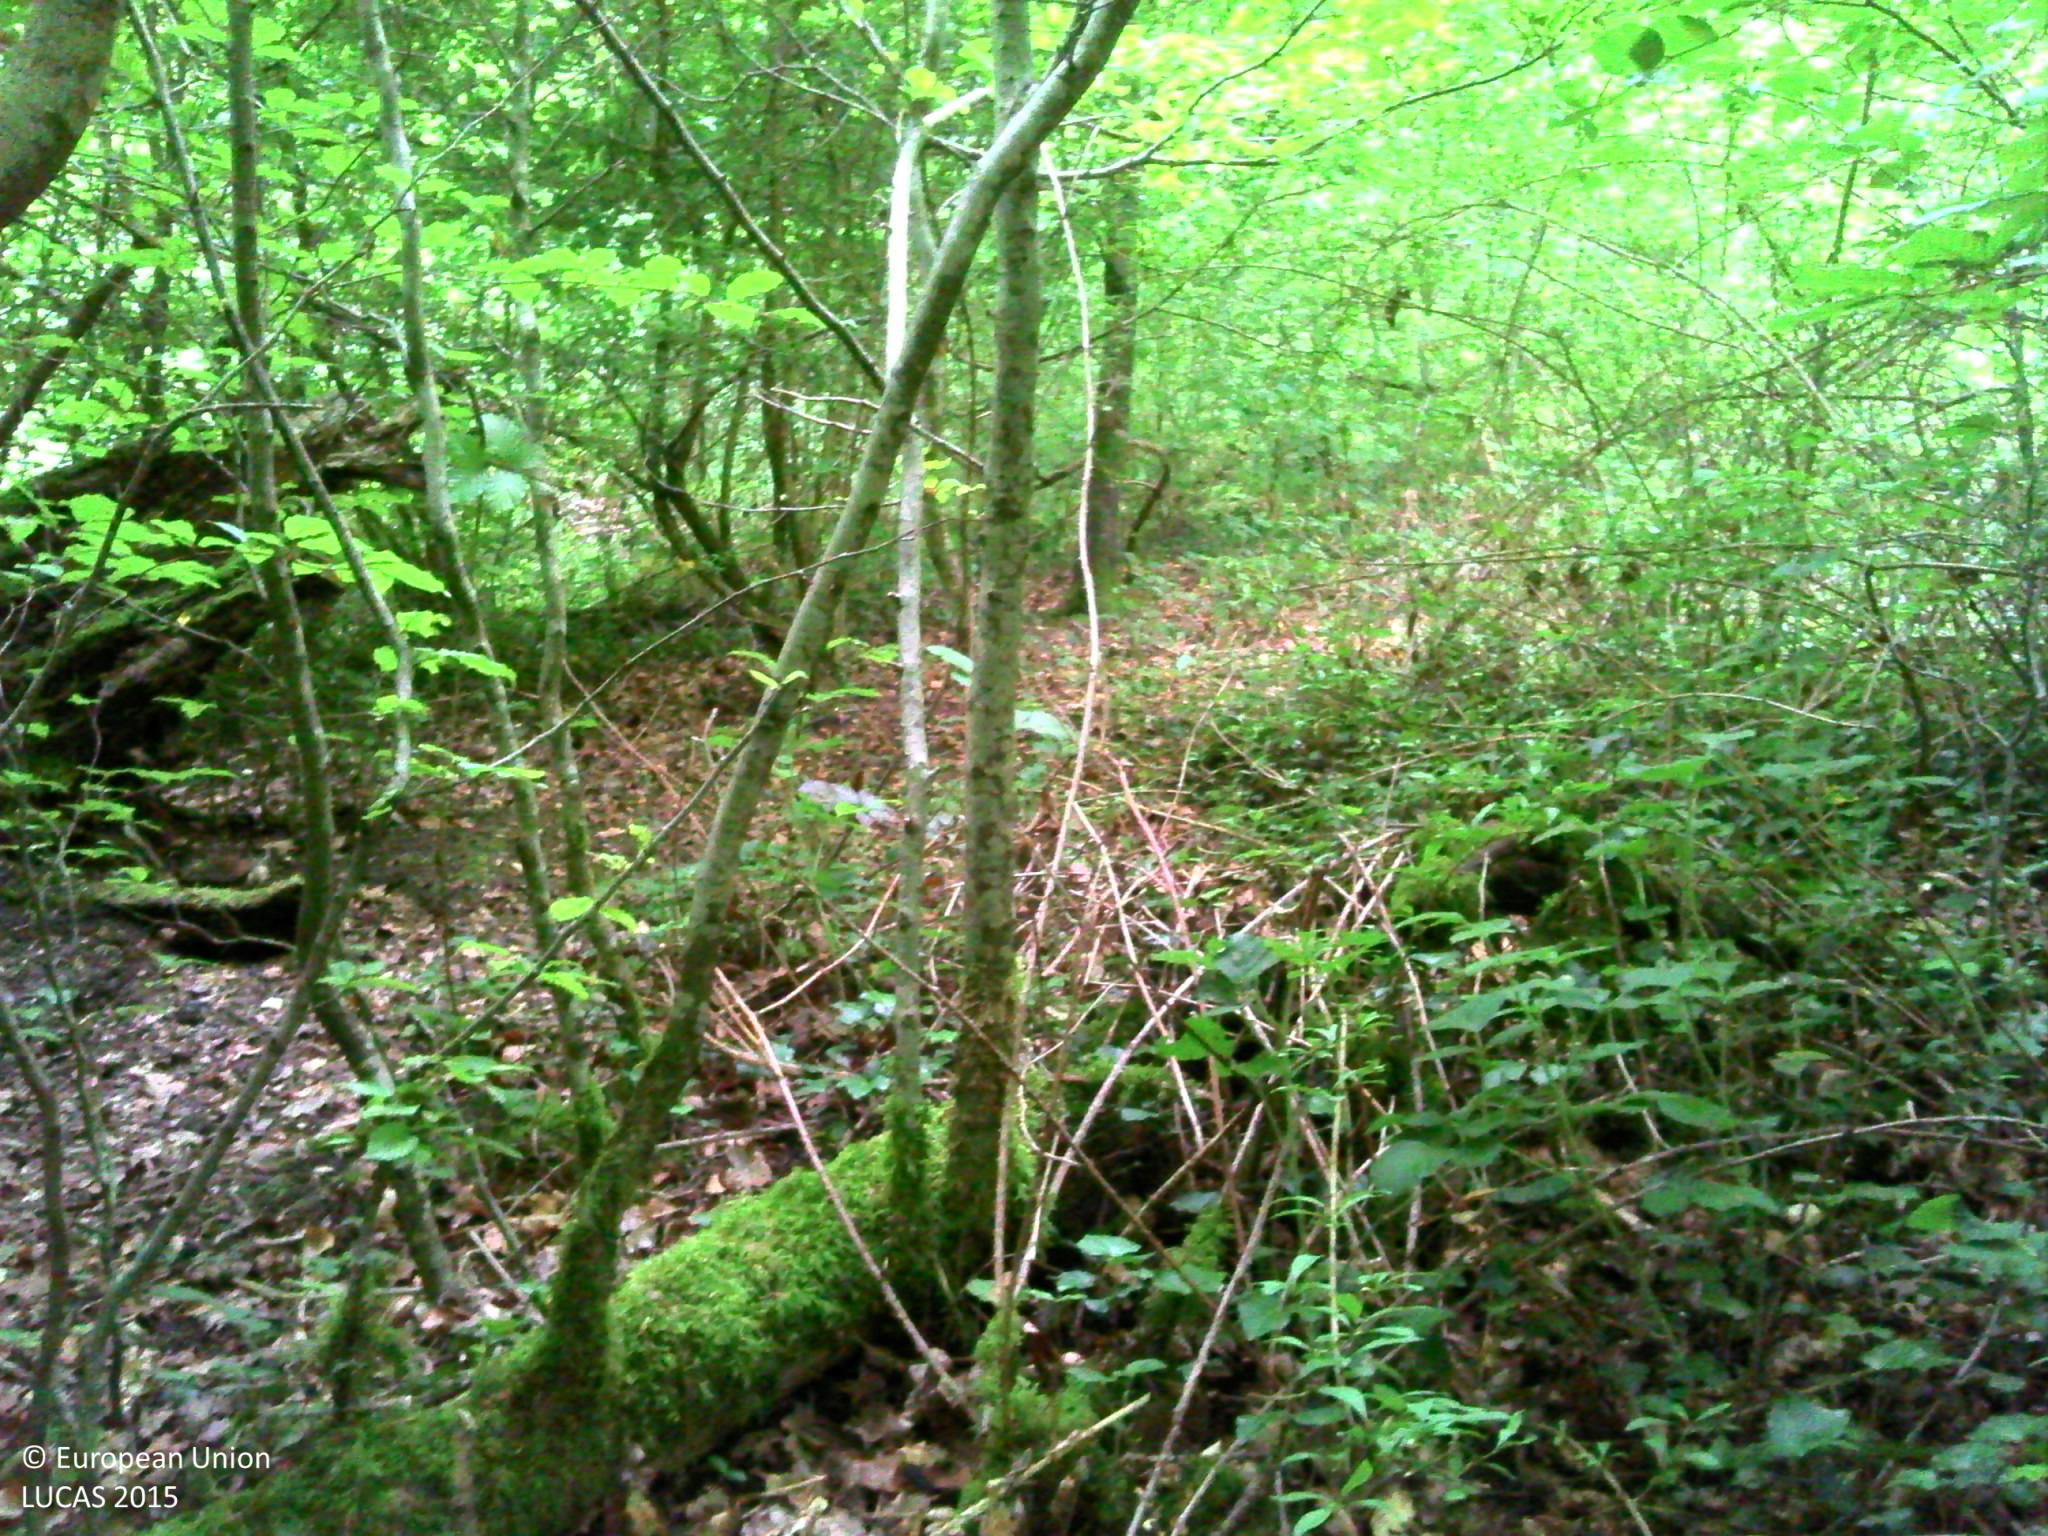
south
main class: Woodland
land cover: Broadleaved woodland
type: mesophytic deciduous forest
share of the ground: > 75 %
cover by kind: broadleaved forest trees 90 %, herbaceous plants 5 %, lichens and mosses 5 %
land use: Forestry
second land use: Amenities, museums, leisure
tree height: > 5 m
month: June
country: FR
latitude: 48.2835
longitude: 3.4852
